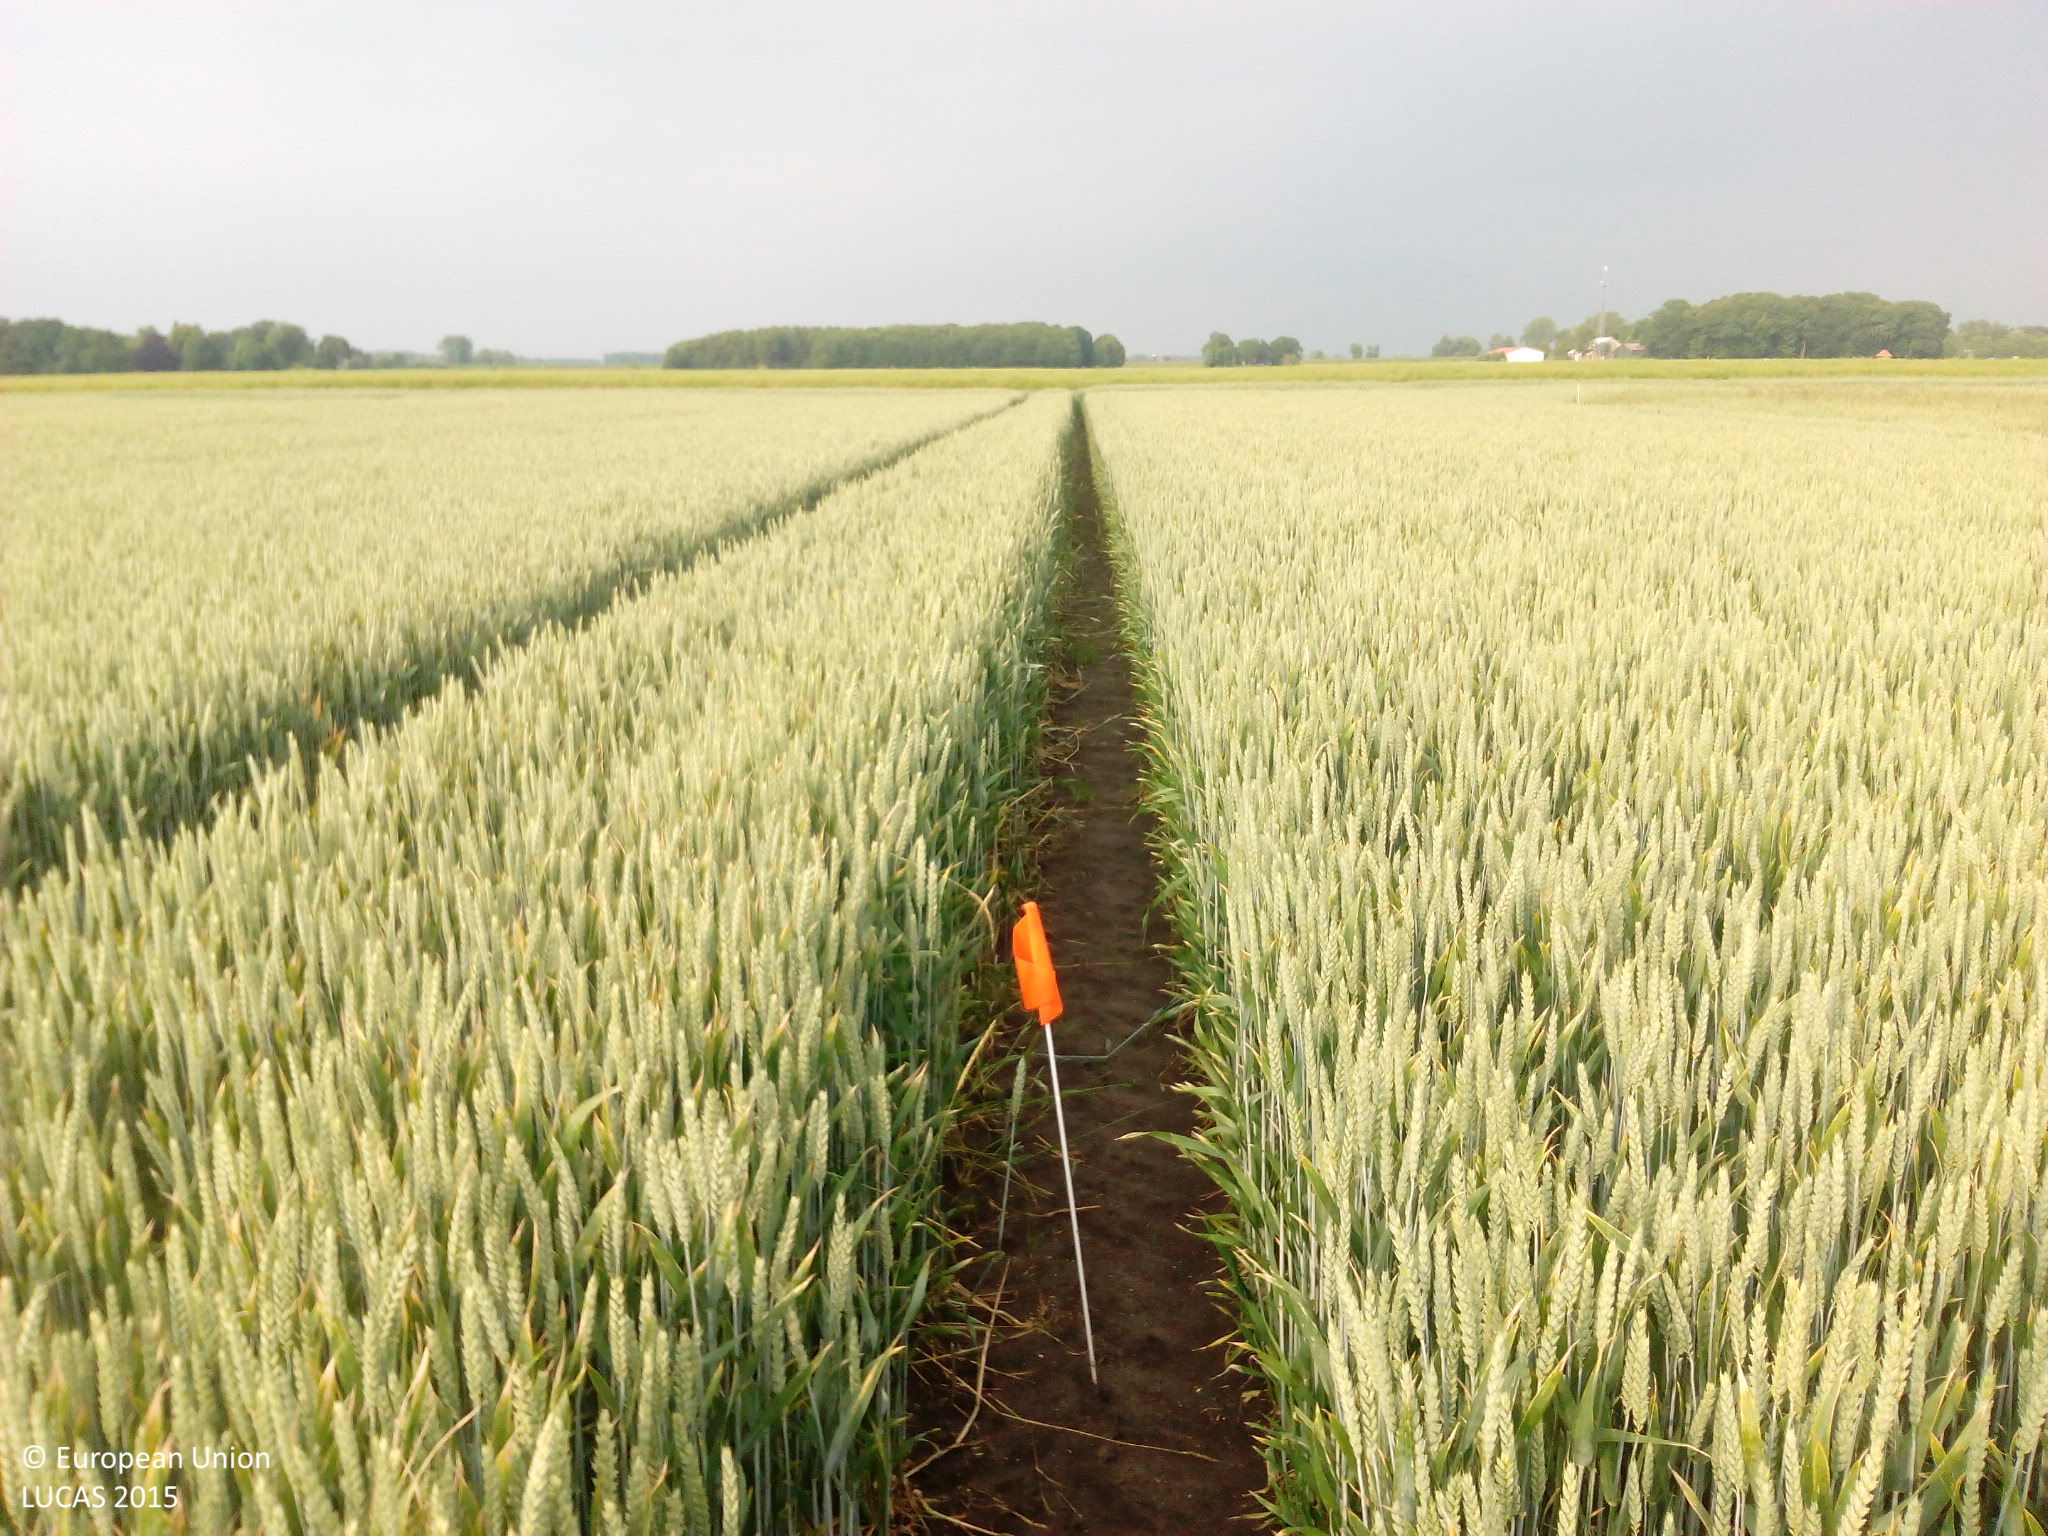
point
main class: Cropland
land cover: Common wheat
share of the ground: > 75 %
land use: Agriculture (excluding fallow land and kitchen gardens)
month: June
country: DE
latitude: 53.7415
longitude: 9.3181
